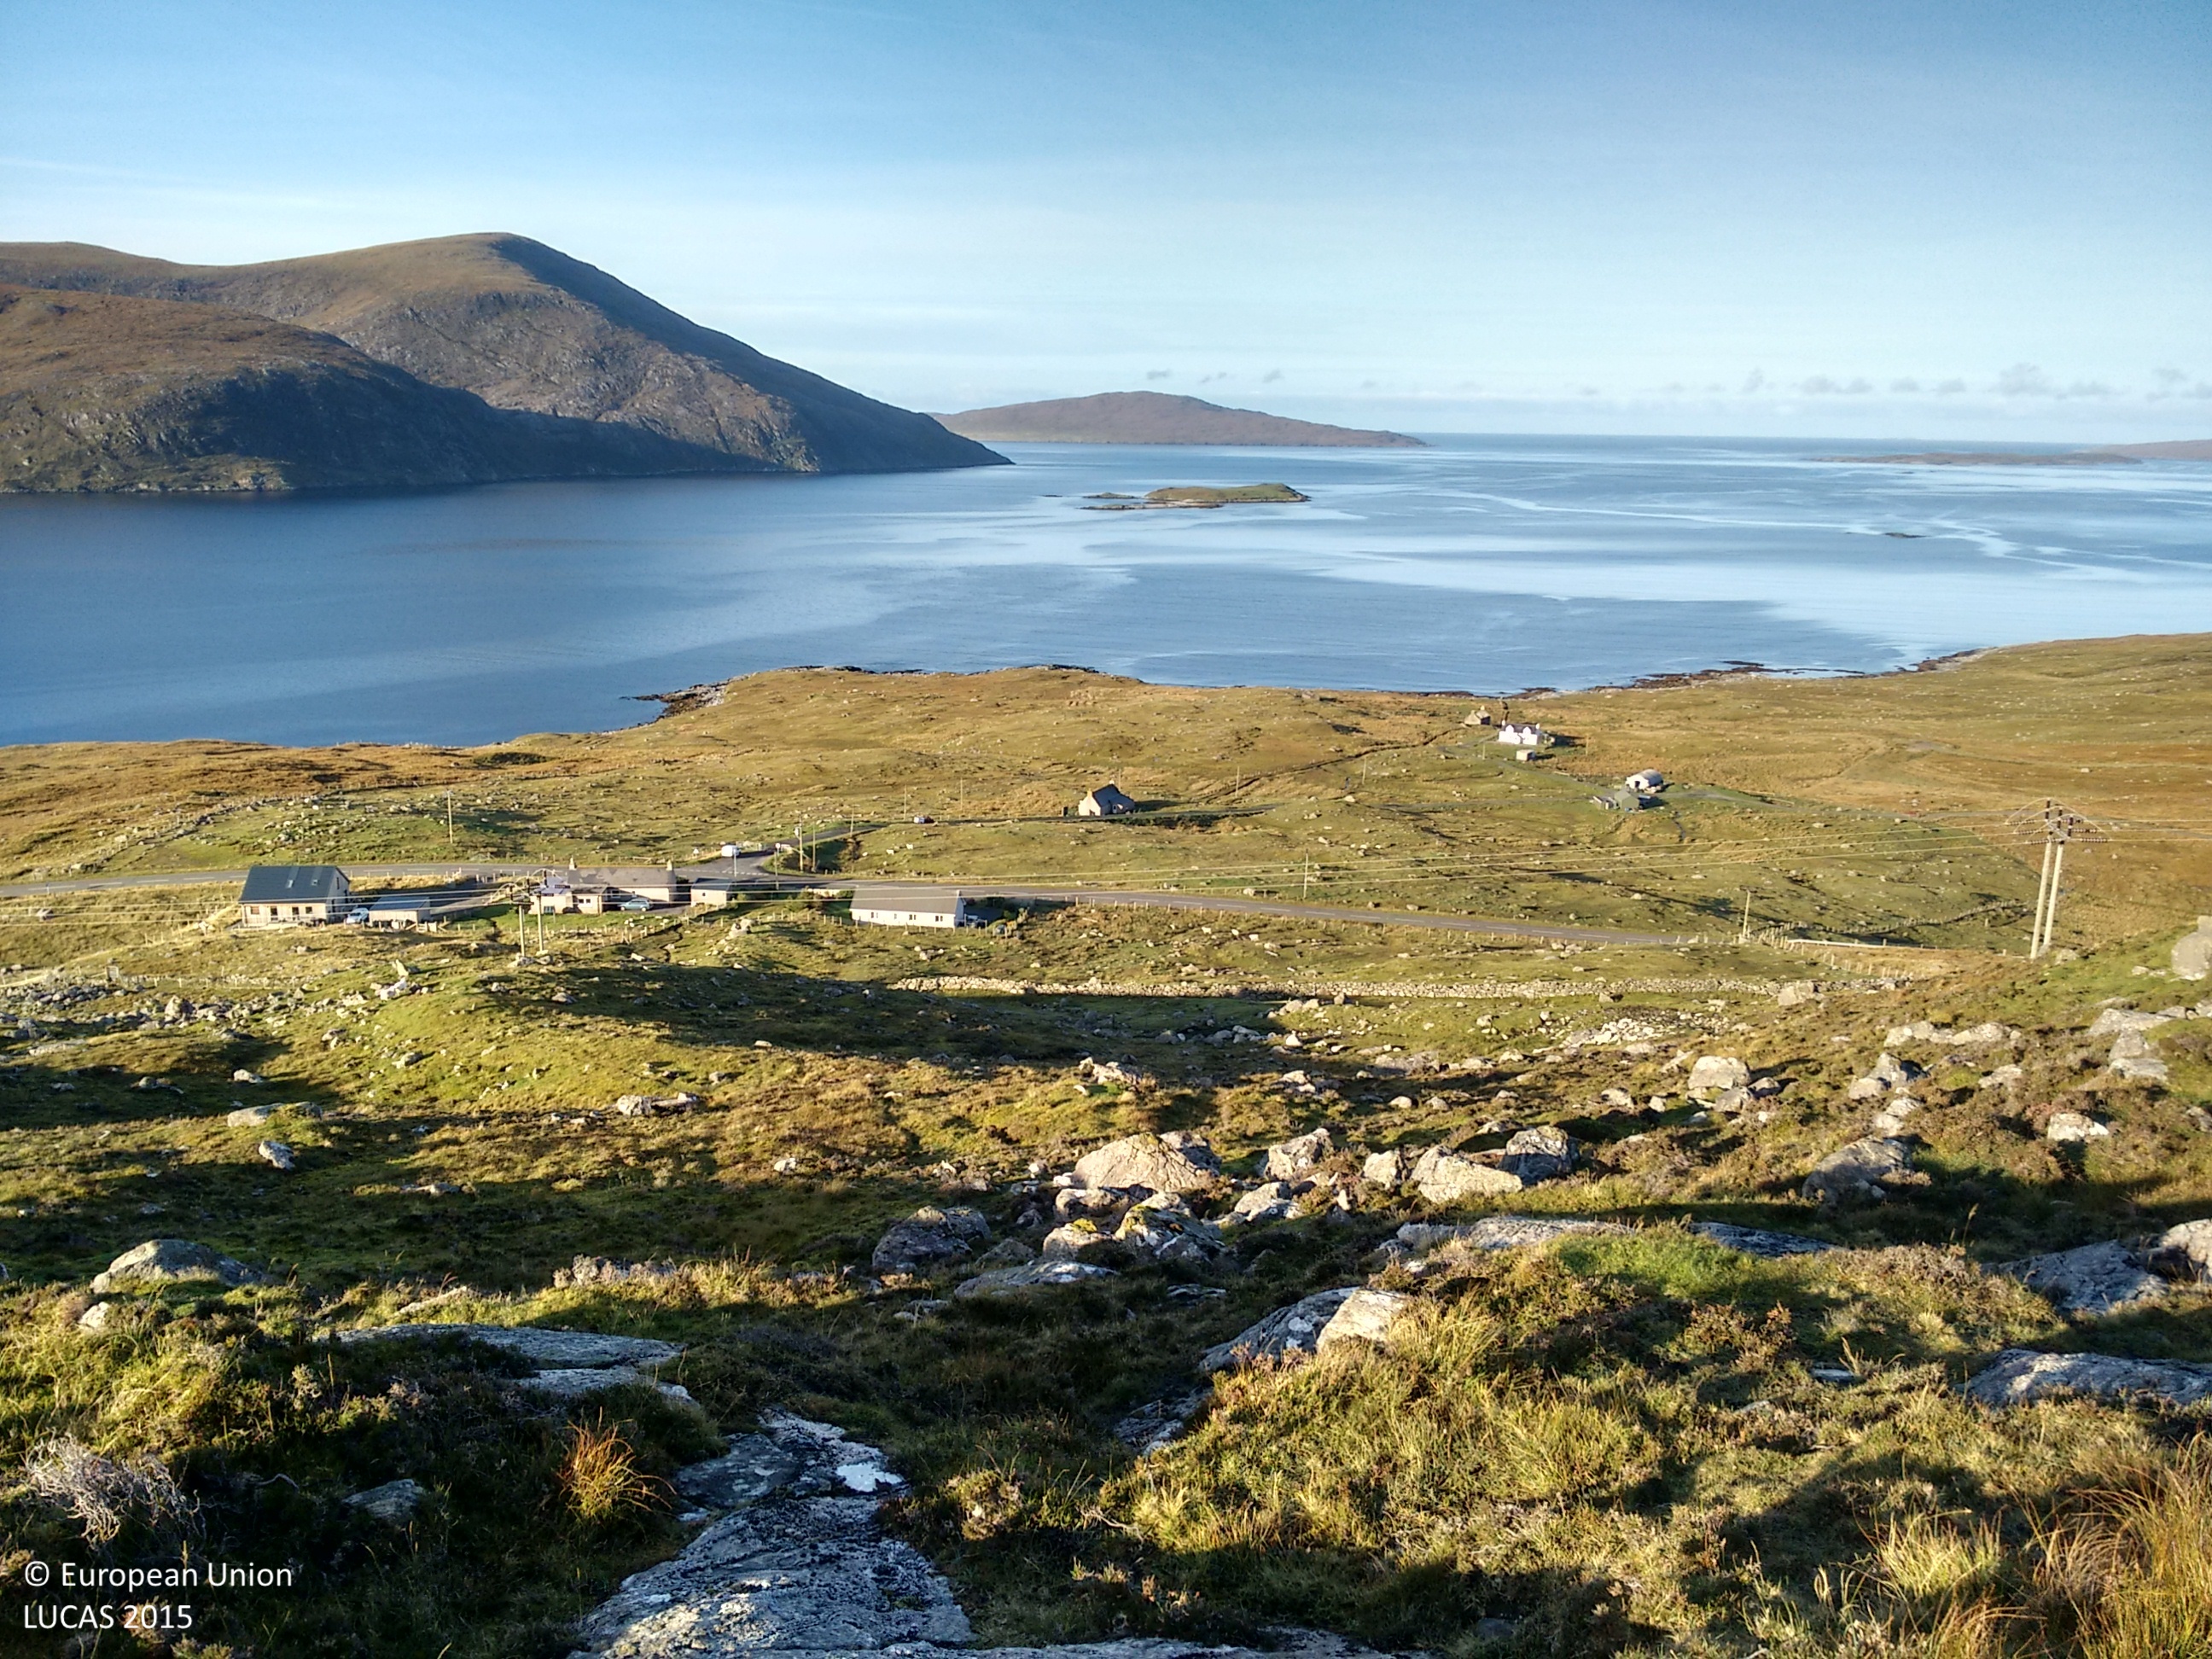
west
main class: Shrubland
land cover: Shrubland without tree cover
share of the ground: 25 - 50 %
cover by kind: herbaceous plants 40 %, shrubs 30 %
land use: Agriculture (excluding fallow land and kitchen gardens)
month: October
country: GB
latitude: 57.9187
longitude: -6.8457
